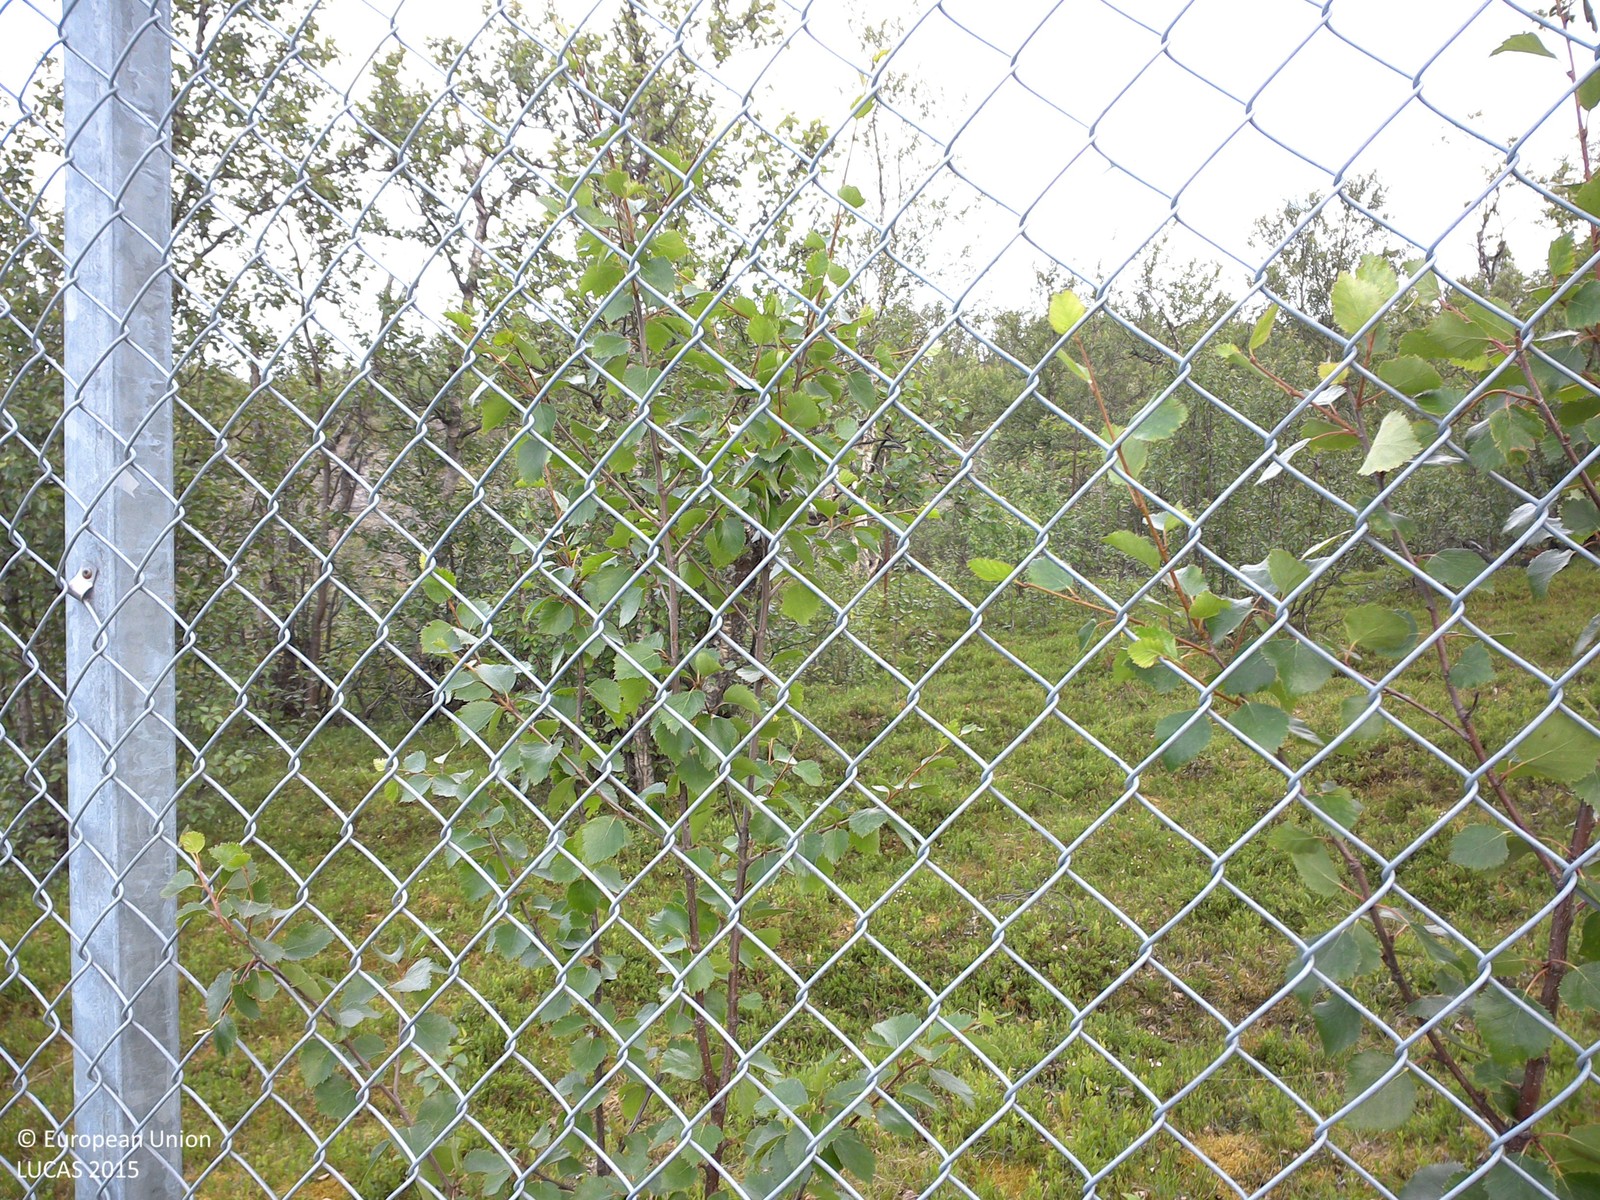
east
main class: Woodland
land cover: Broadleaved woodland
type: boreal forest
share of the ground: 10 - 25 %
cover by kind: shrubs 80 %, broadleaved forest trees 20 %
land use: Mining and quarrying
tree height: > 5 m
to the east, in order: Broadleaved woodland
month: August
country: SE
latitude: 67.8728
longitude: 20.1446
